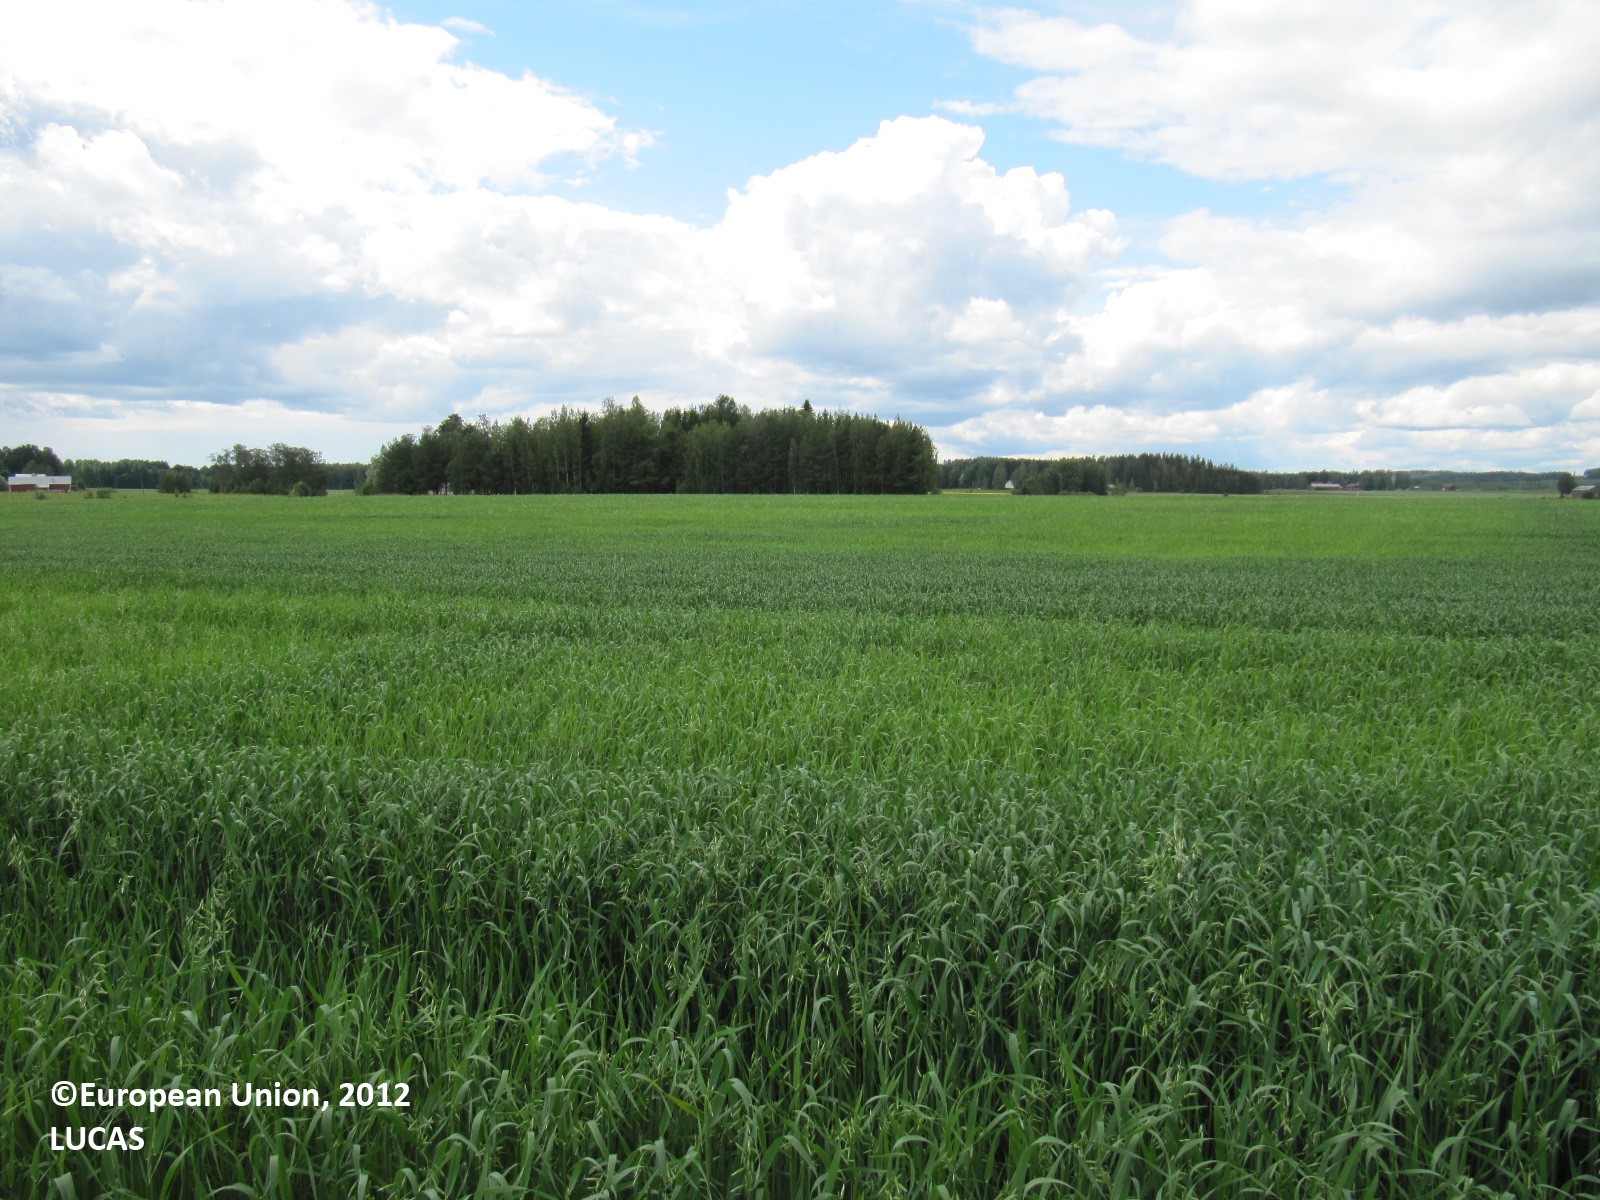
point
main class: Cropland
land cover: Oats
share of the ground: > 75 %
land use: Agriculture (excluding fallow land and kitchen gardens)
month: July
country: FI
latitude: 60.7847
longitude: 24.6727
